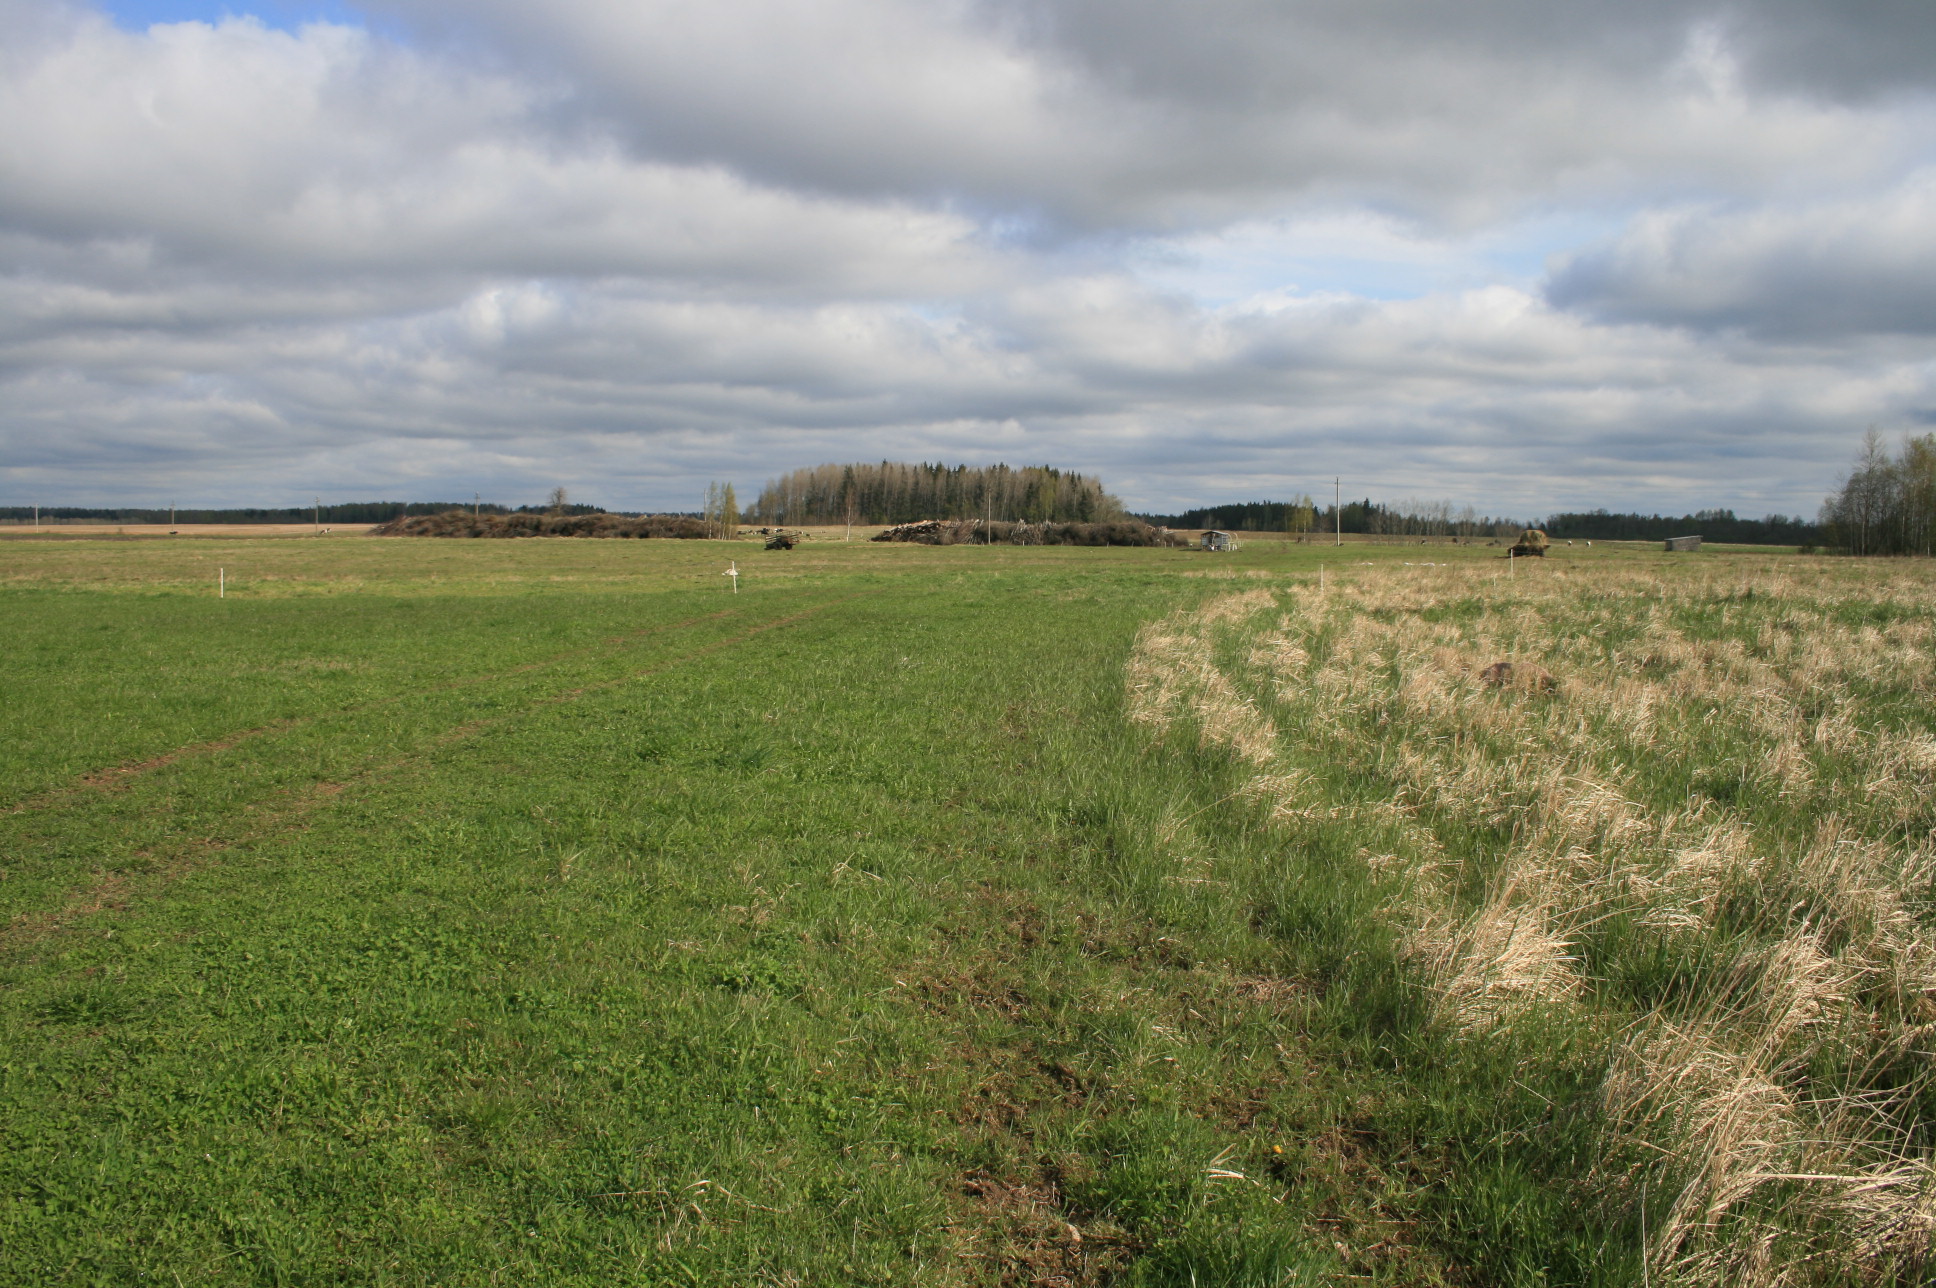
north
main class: Grassland
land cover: Grassland without tree/shrub cover
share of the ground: > 75 %
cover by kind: herbaceous plants 100 %
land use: Agriculture (excluding fallow land and kitchen gardens)
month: May
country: LT
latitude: 56.4025
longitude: 22.0247
